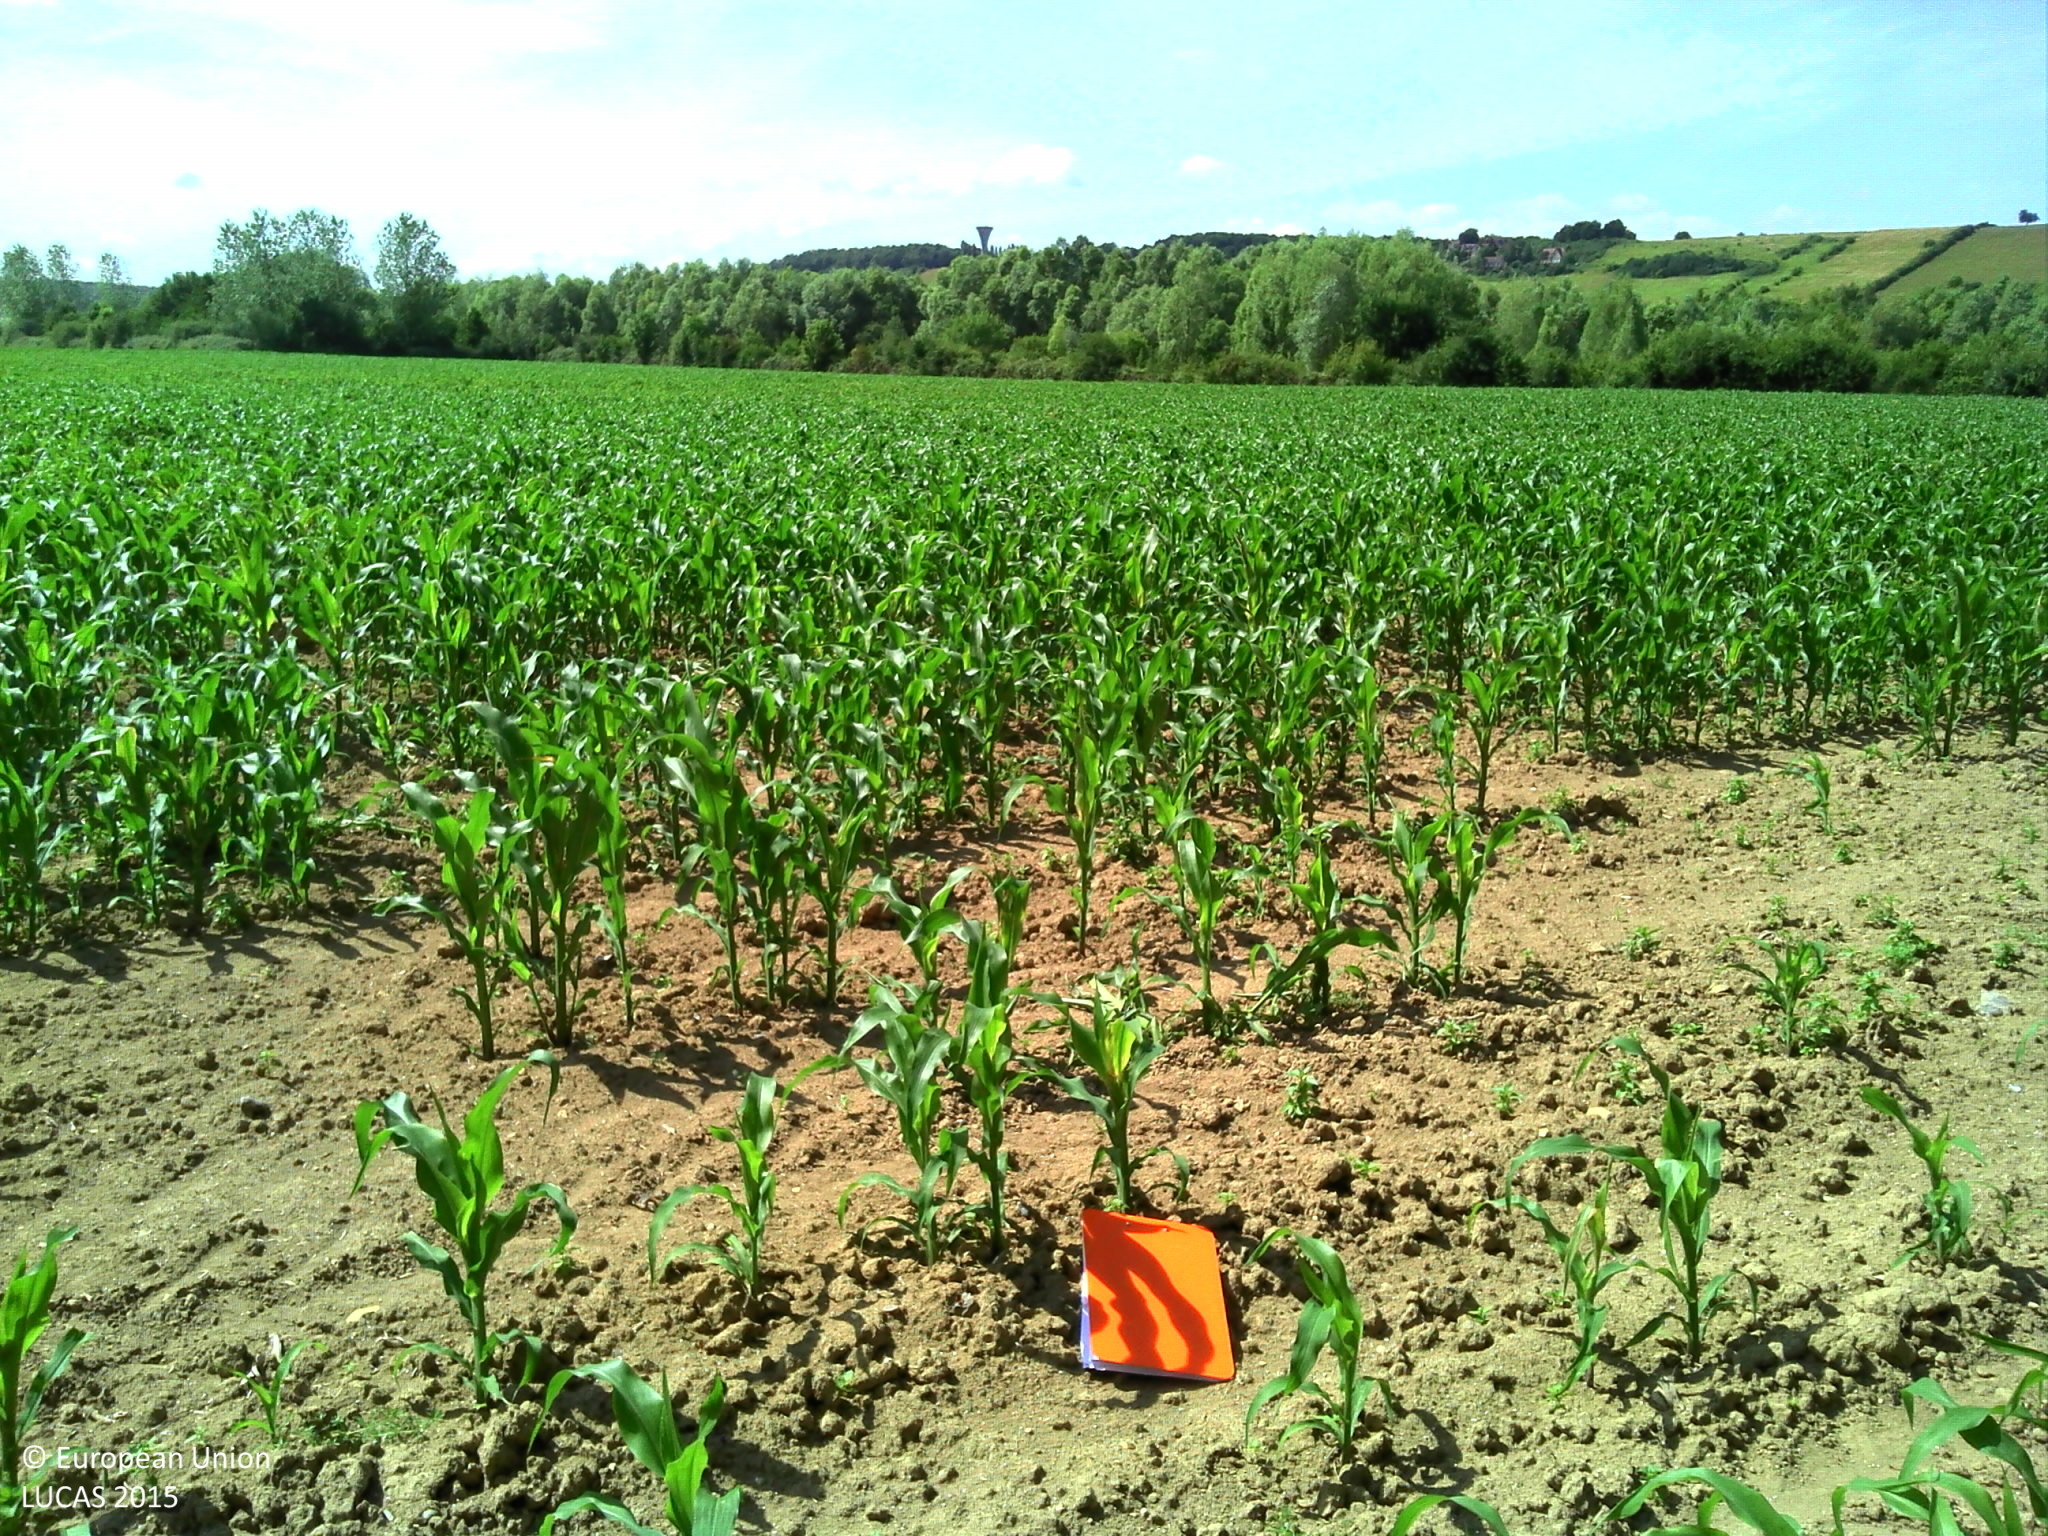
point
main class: Cropland
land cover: Maize
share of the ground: 25 - 50 %
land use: Agriculture (excluding fallow land and kitchen gardens)
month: June
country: FR
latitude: 49.3136
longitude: 1.1341
